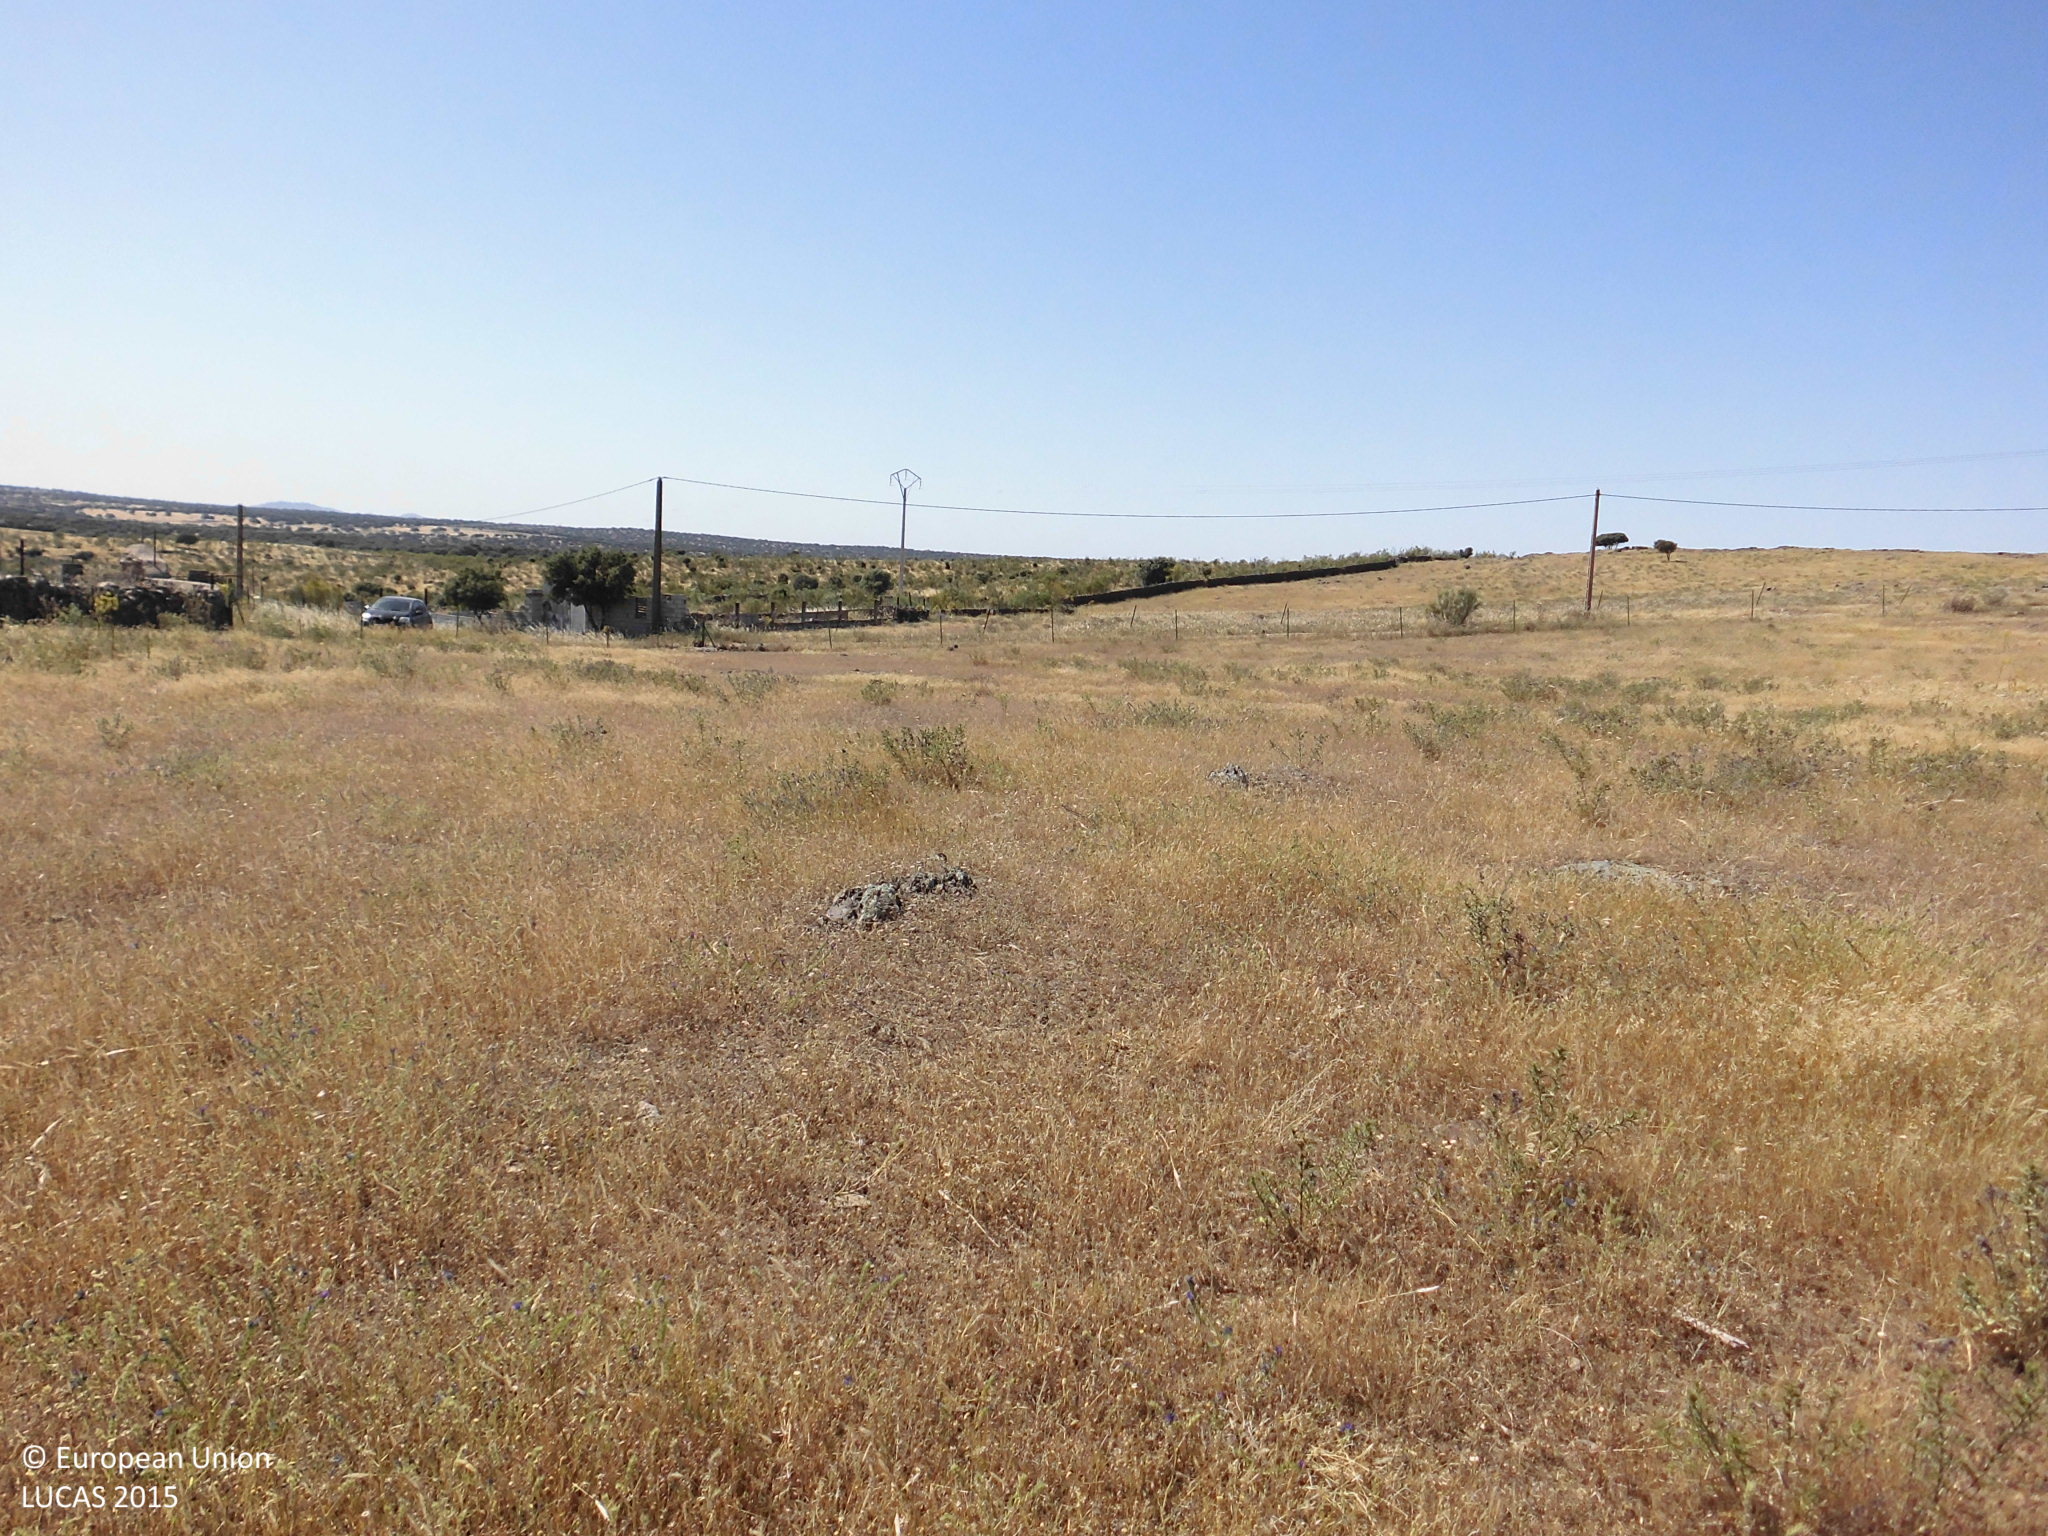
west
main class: Grassland
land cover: Grassland without tree/shrub cover
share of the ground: > 75 %
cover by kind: herbaceous plants 100 %
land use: Agriculture (excluding fallow land and kitchen gardens)
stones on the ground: 10 - 25 %
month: May
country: ES
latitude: 39.3750
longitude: -6.0680
